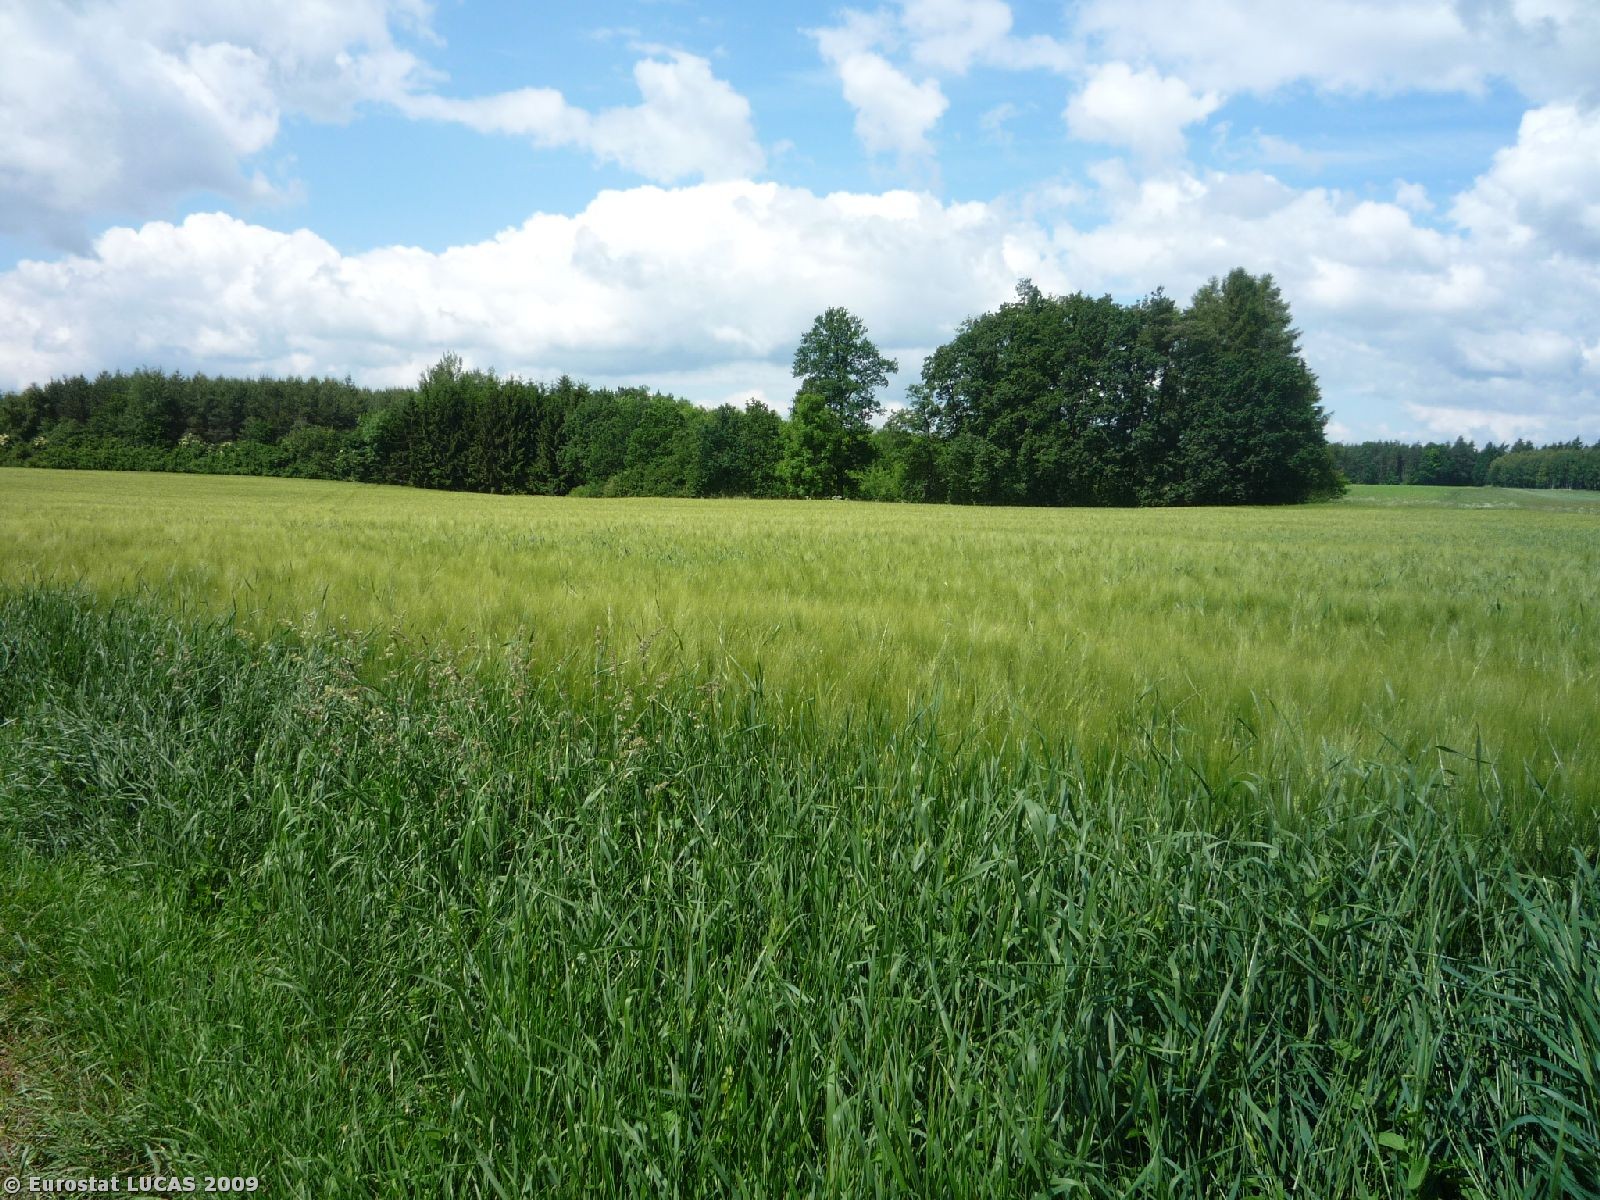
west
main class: Cropland
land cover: Barley
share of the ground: > 75 %
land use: Agriculture (excluding fallow land and kitchen gardens)
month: June
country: CZ
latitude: 50.4283
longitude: 15.5365
